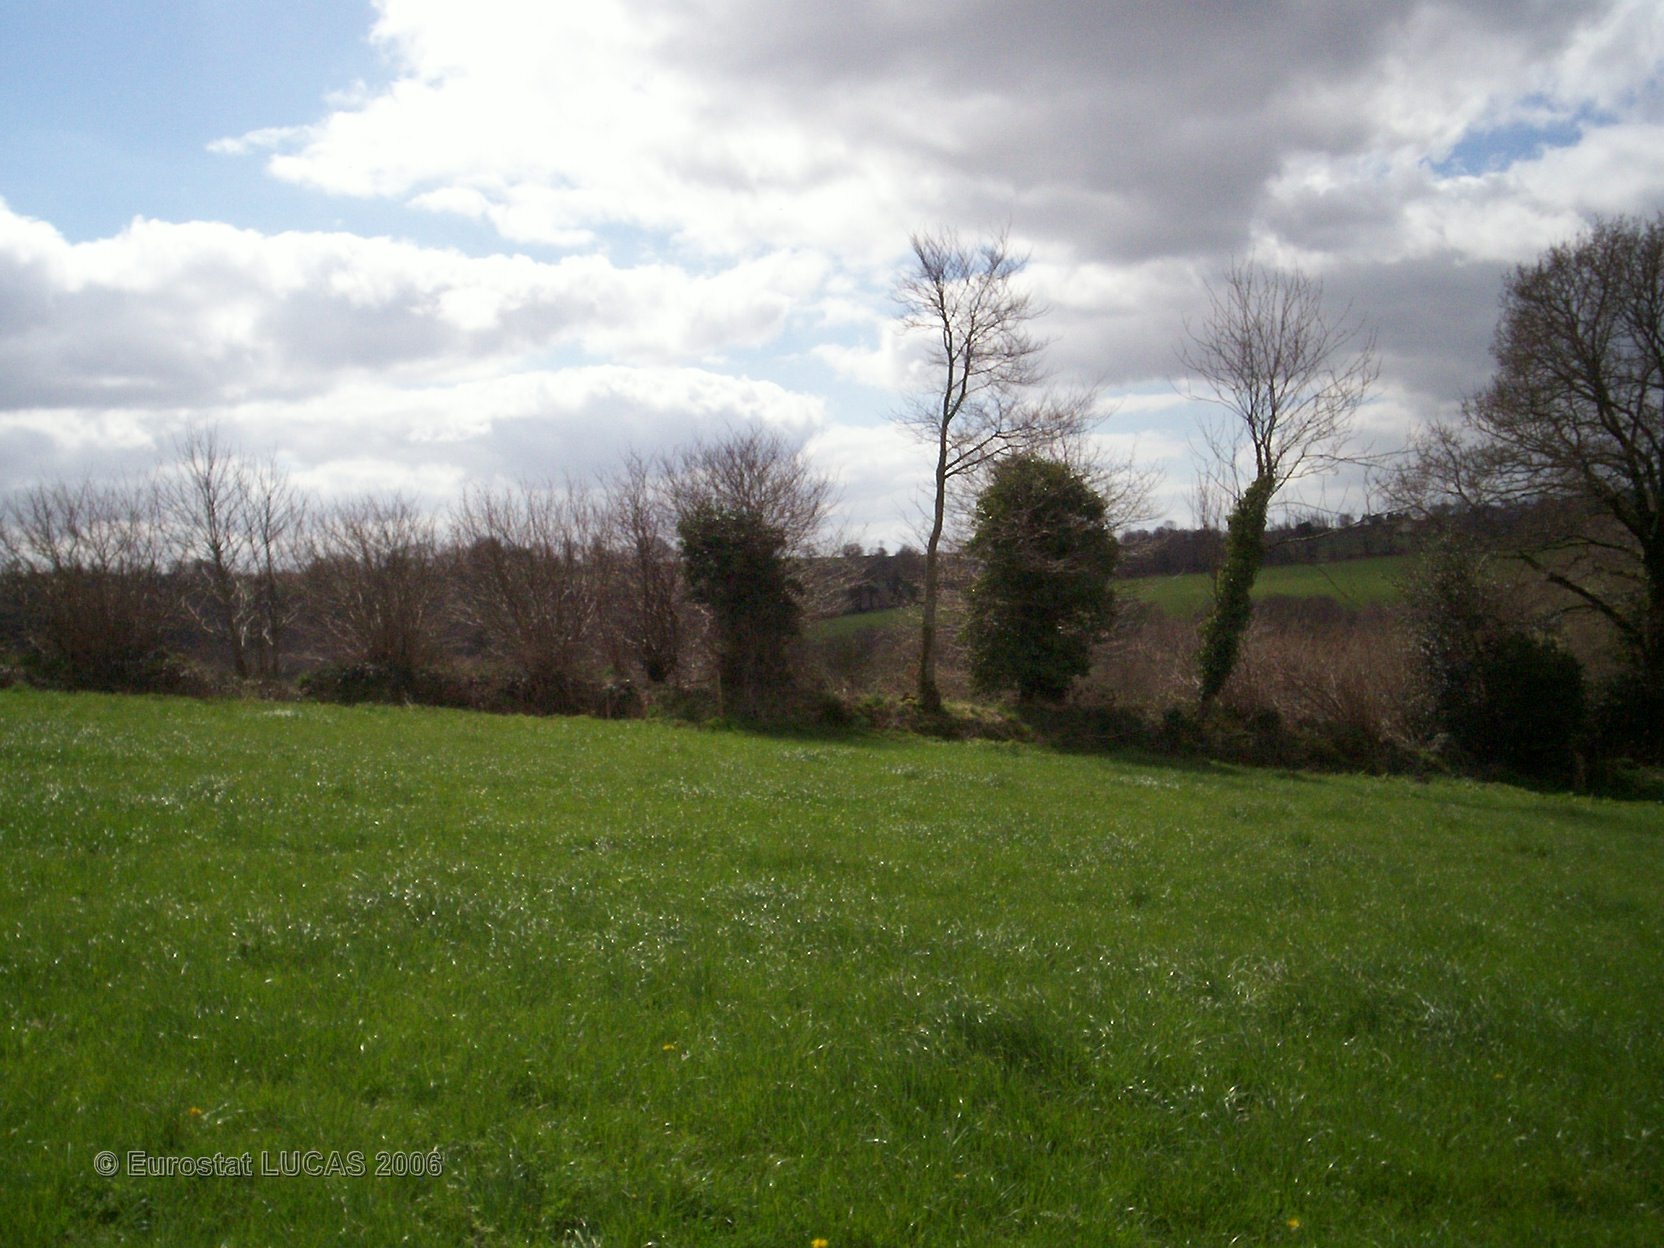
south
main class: Grassland
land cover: Grassland without tree/shrub cover
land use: Agriculture (excluding fallow land and kitchen gardens)
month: April
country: FR
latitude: 48.0987
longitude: -3.6559
